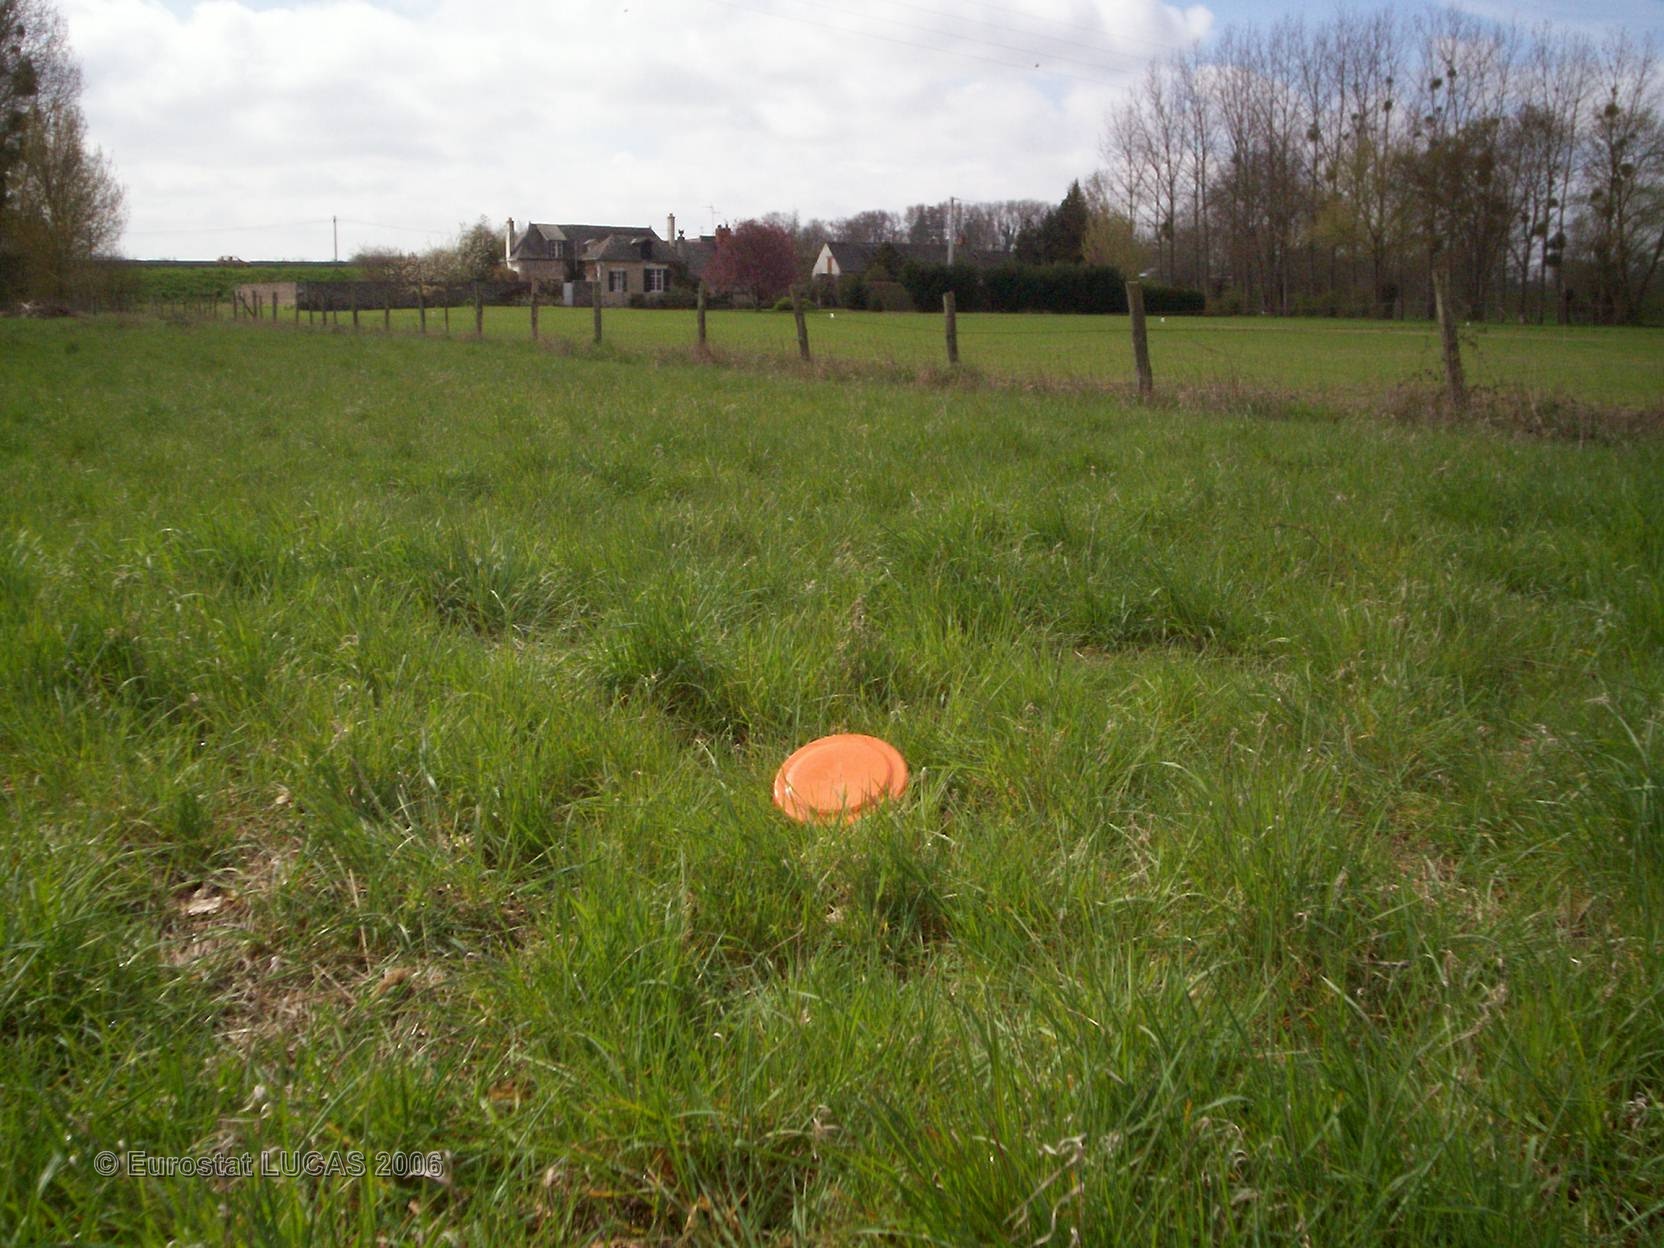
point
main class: Grassland
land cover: Grassland without tree/shrub cover
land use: Agriculture (excluding fallow land and kitchen gardens)
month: April
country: FR
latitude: 47.4210
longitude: -0.4087
